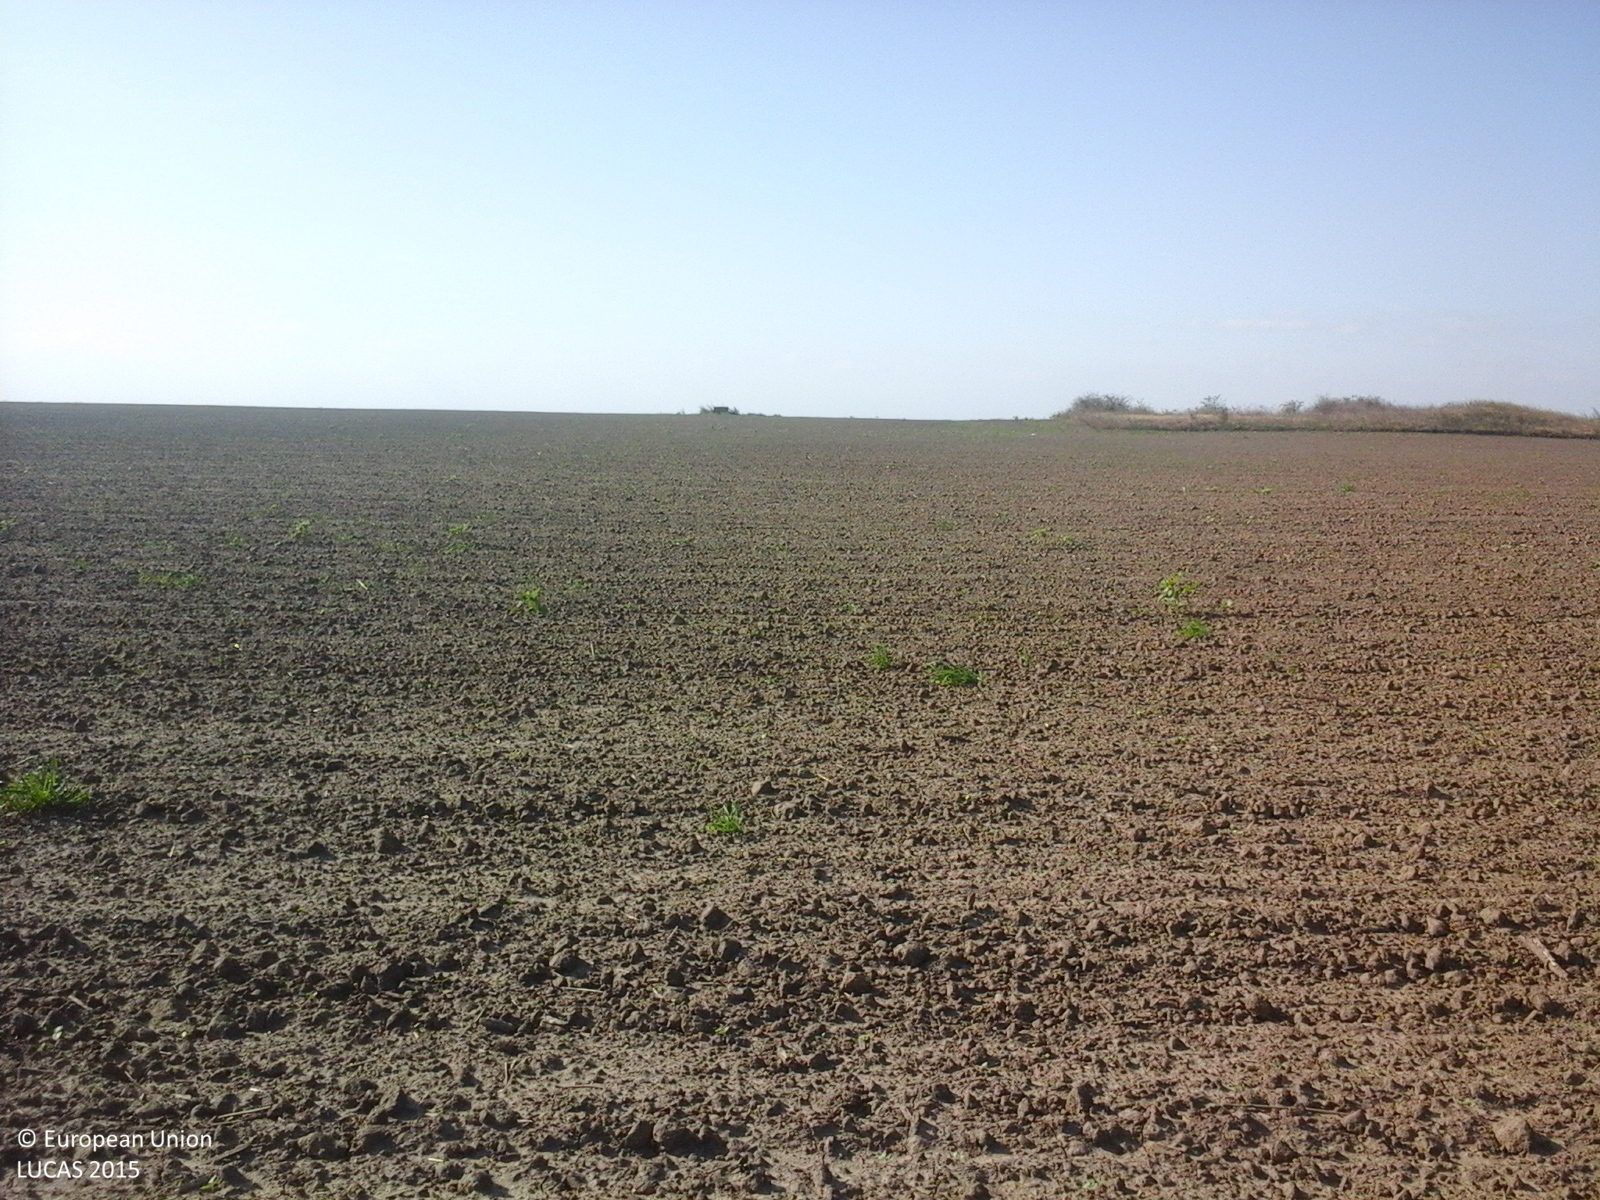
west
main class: Cropland
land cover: Maize
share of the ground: < 10 %
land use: Agriculture (excluding fallow land and kitchen gardens)
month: October
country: RO
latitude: 45.3362
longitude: 27.3883
